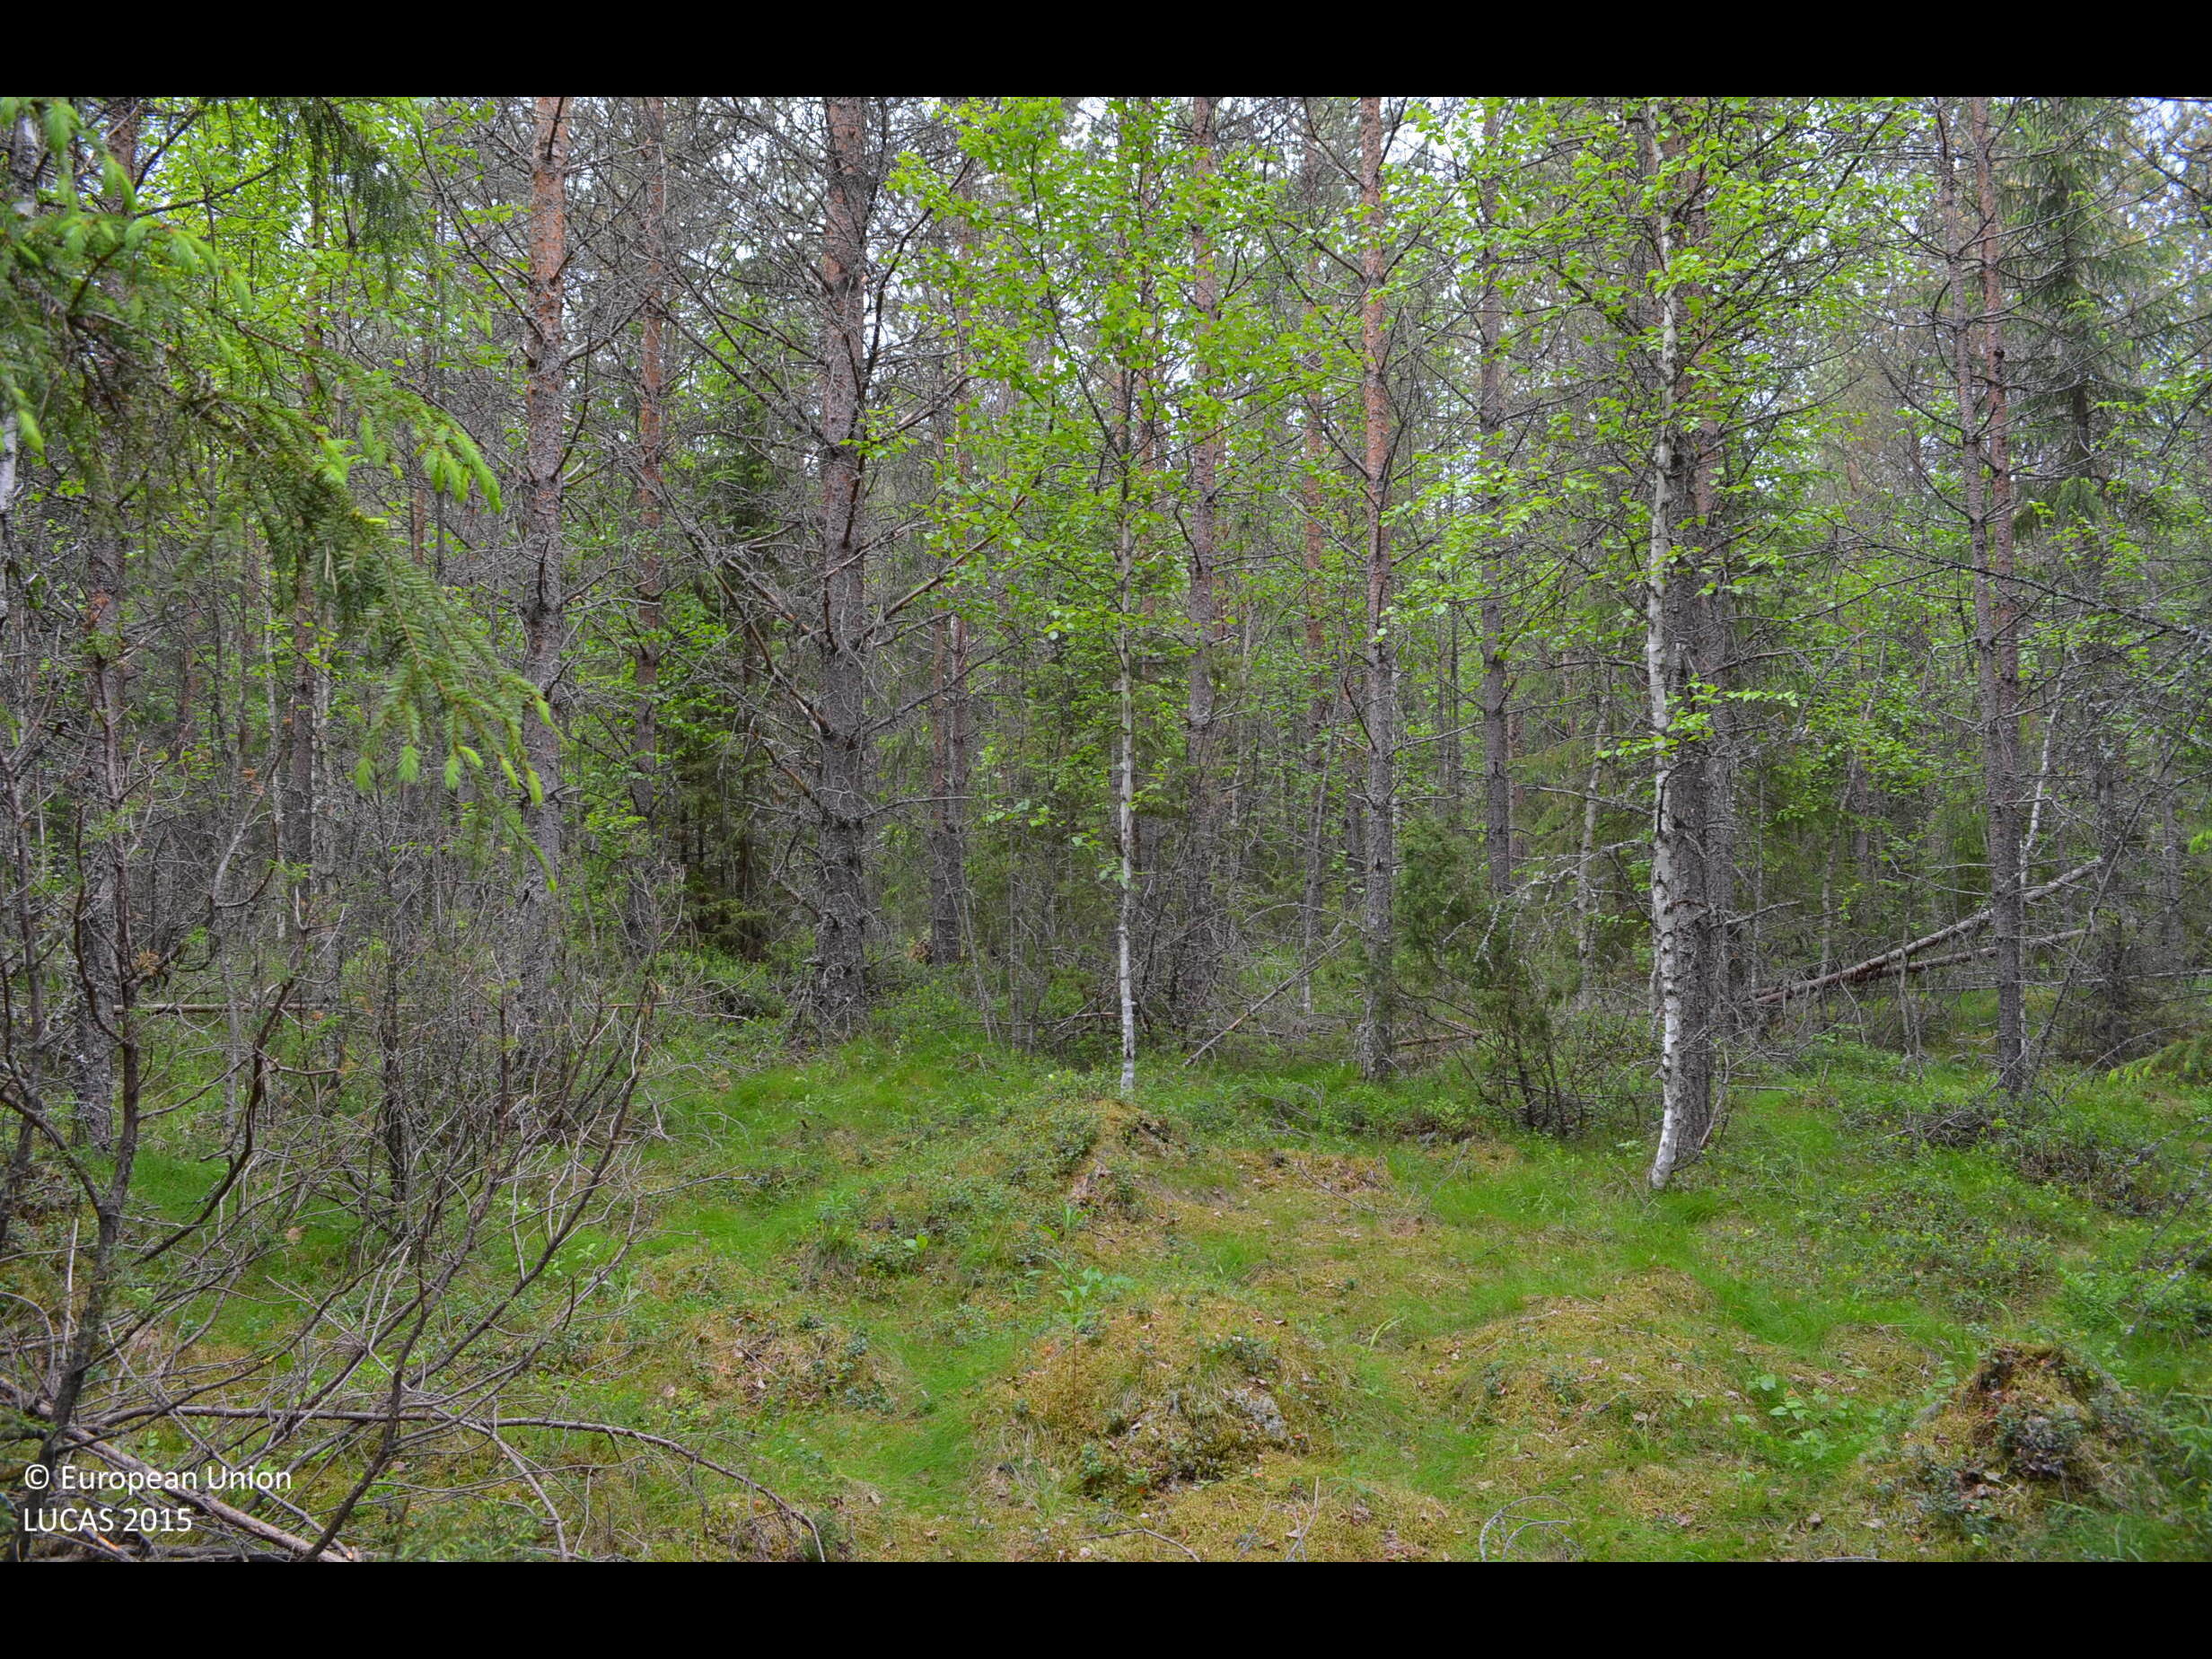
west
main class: Woodland
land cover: Other mixed woodland
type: boreal forest
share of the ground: > 75 %
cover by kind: coniferous forest trees 65 %, broadleaved forest trees 25 %, shrubs 5 %, herbaceous plants 5 %
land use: Forestry
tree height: > 5 m
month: June
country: FI
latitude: 61.9650
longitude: 23.2889
